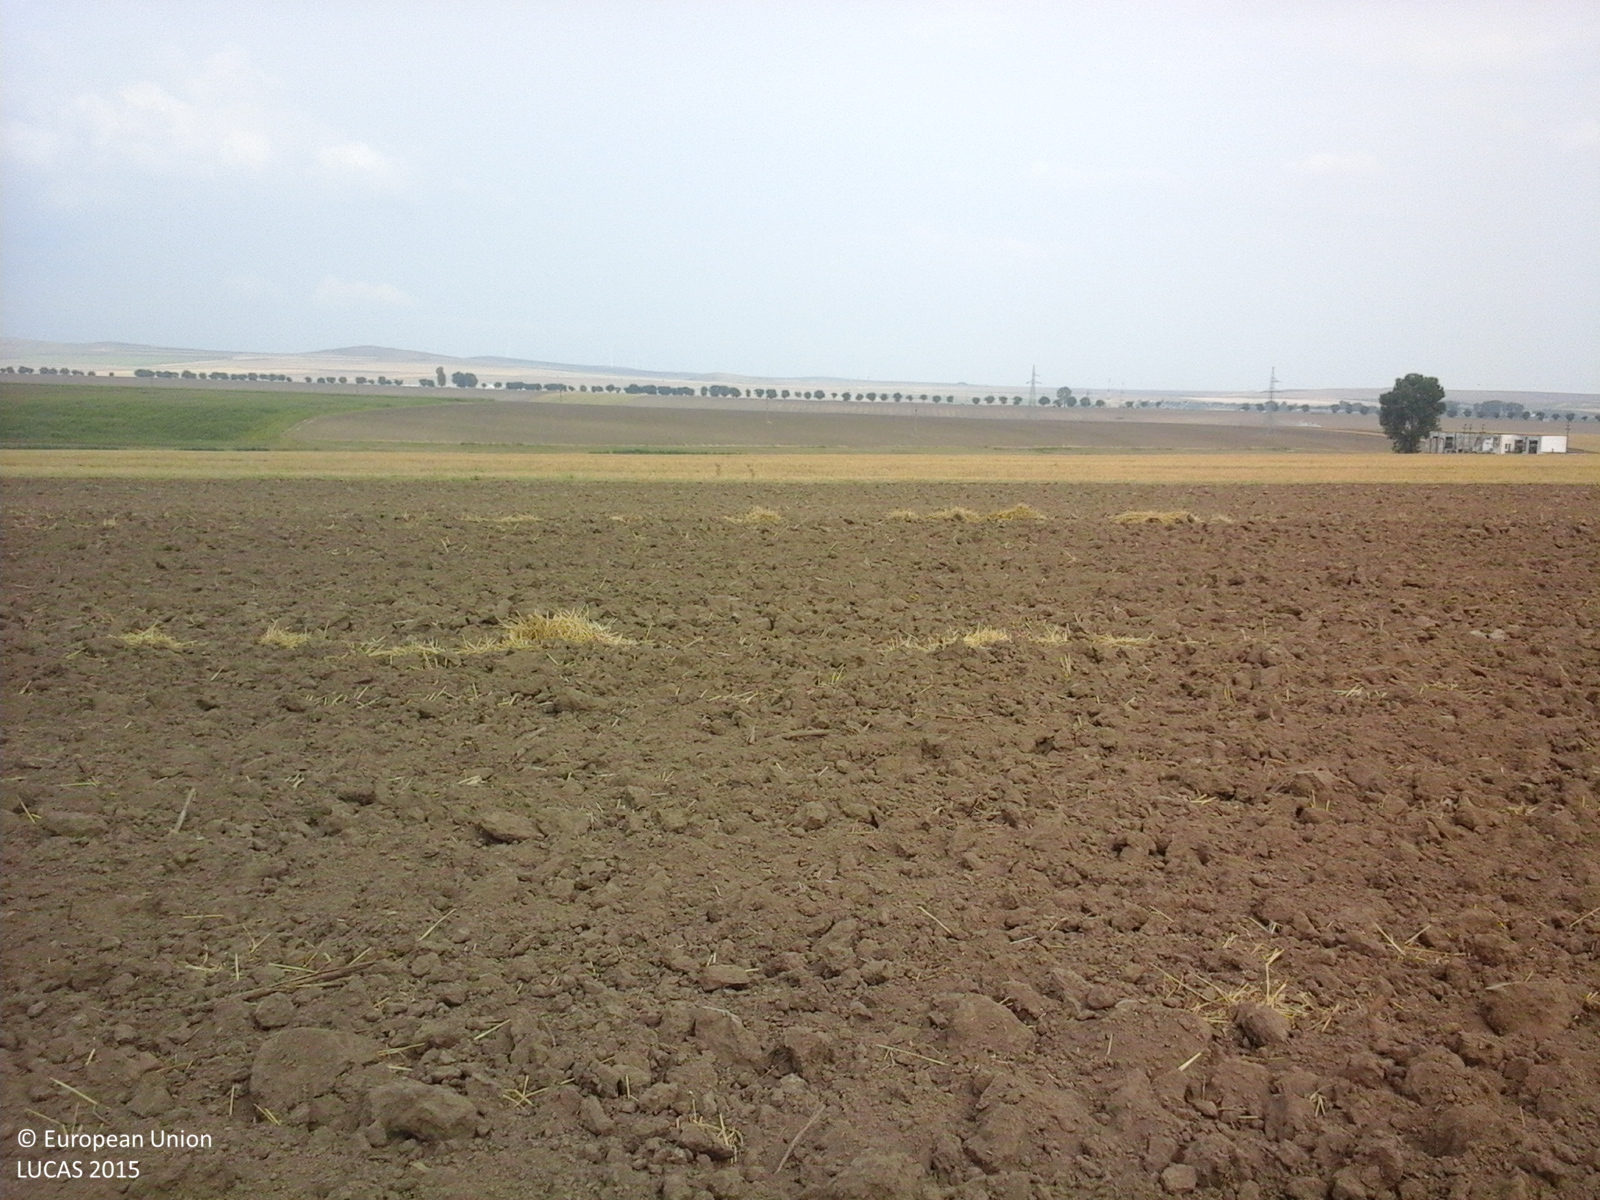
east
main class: Cropland
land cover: Maize
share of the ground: > 75 %
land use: Agriculture (excluding fallow land and kitchen gardens)
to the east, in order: Maize; Other bare soil; Common wheat
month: July
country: RO
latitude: 45.0152
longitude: 28.7001
